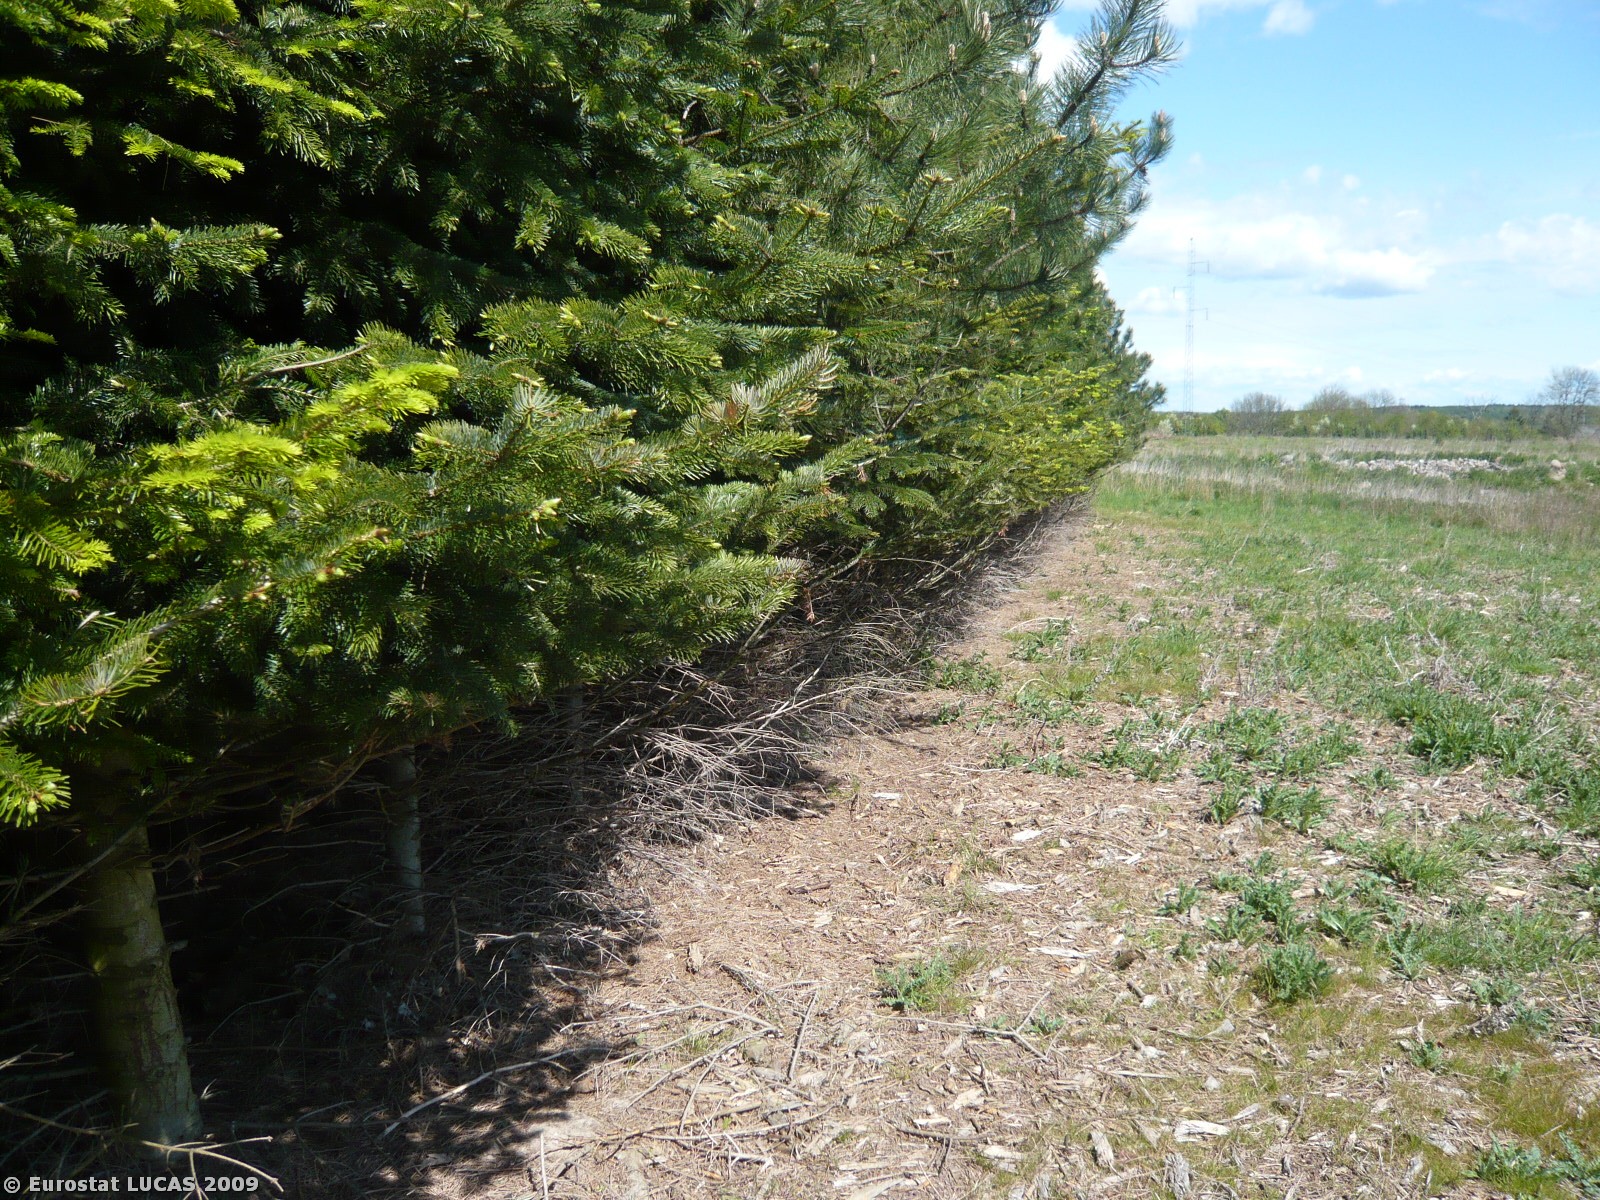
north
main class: Grassland
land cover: Spontaneously vegetated surfaces
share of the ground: 10 - 25 %
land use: Forestry
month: May
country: DK
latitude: 55.0756
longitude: 11.9878
